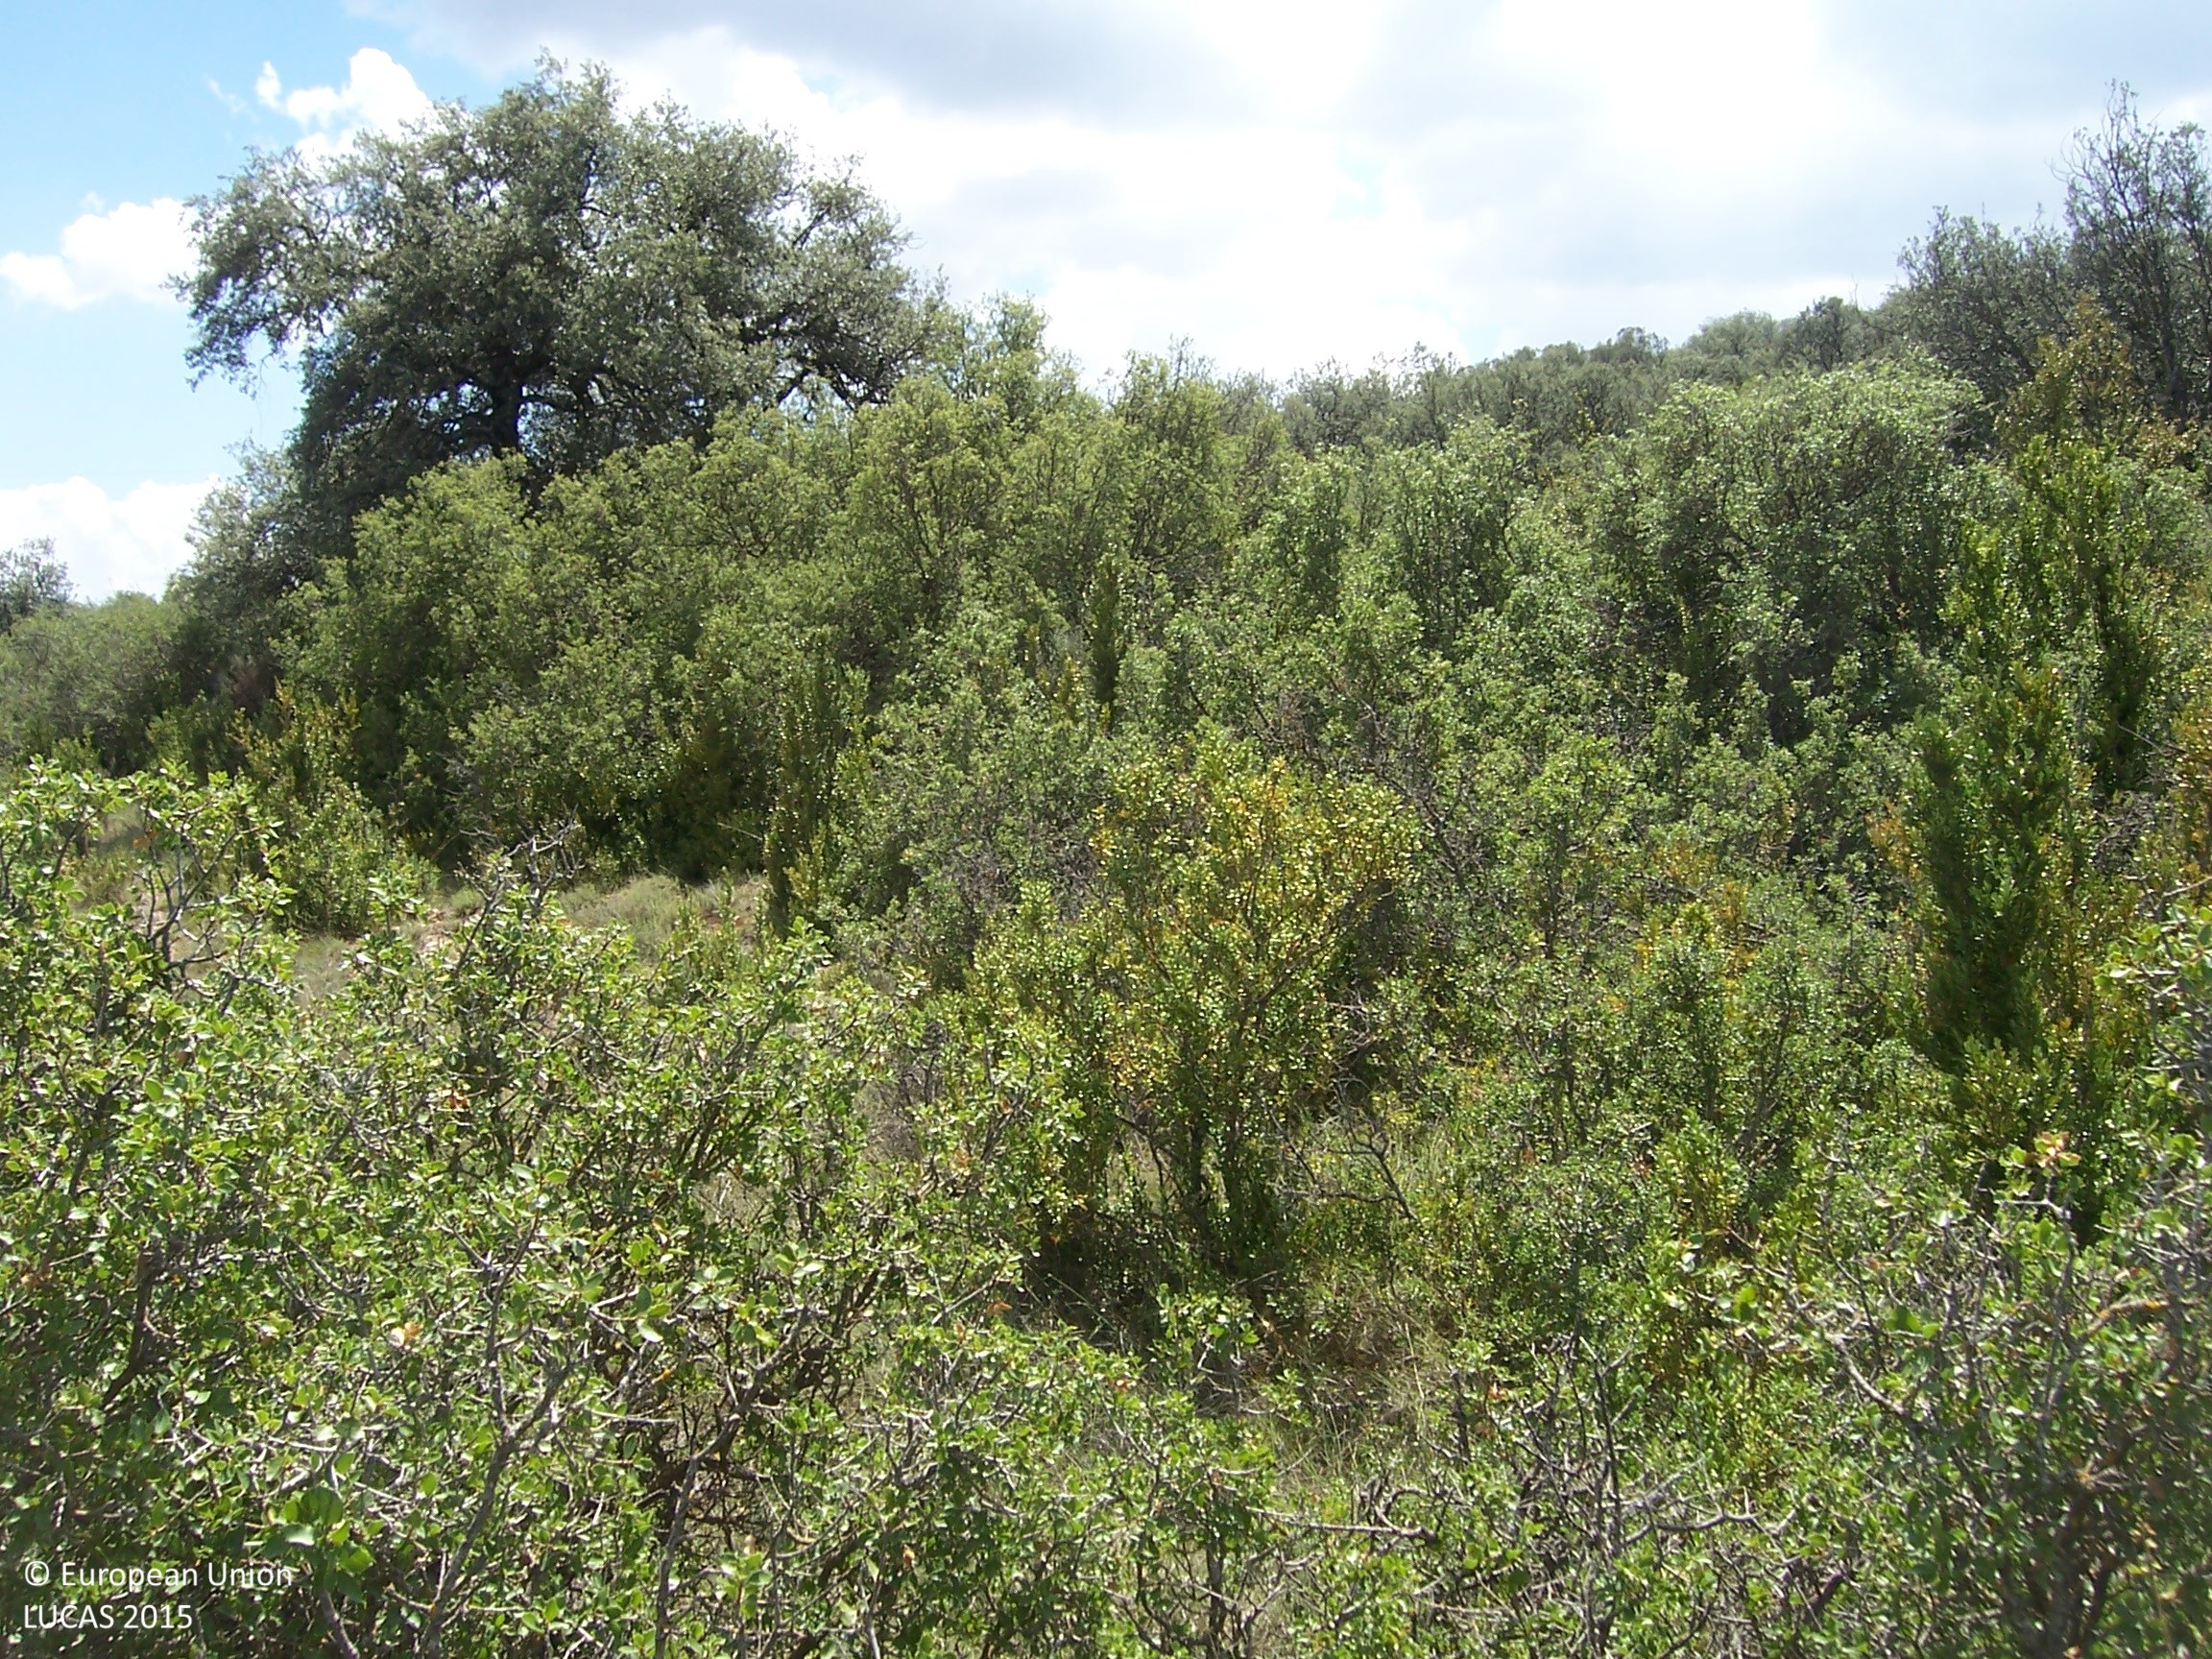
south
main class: Shrubland
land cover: Shrubland without tree cover
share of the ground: > 75 %
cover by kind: shrubs 85 %, unconsolidated bare surface 15 %
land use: Semi-natural and natural areas not in use
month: August
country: ES
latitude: 41.9737
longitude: 0.5354
